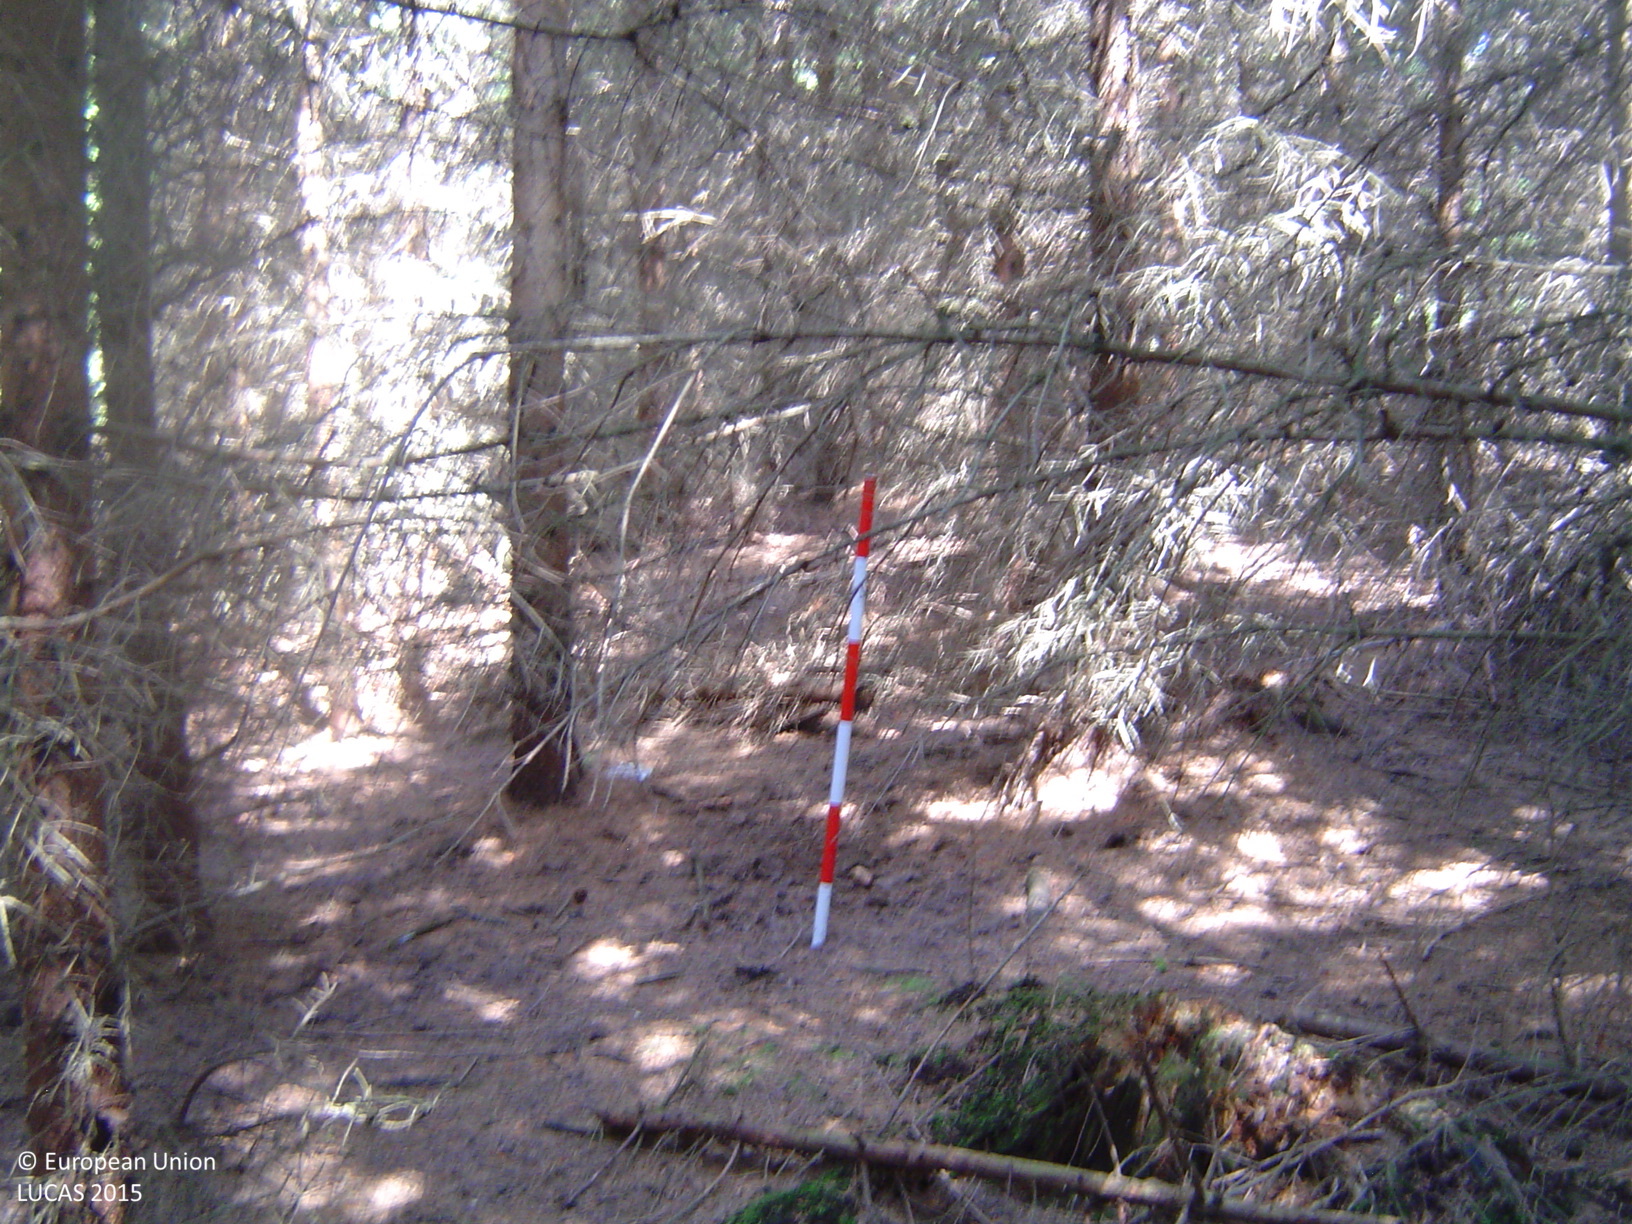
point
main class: Woodland
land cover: Spruce dominated coniferous woodland
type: hemiboreal forest and nemoral coniferous forest and mixed broadleaved-coniferous forest
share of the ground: > 75 %
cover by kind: coniferous forest trees 100 %
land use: Forestry
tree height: > 5 m
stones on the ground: 25 - 50 %
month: July
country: CZ
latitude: 49.2578
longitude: 16.2026
